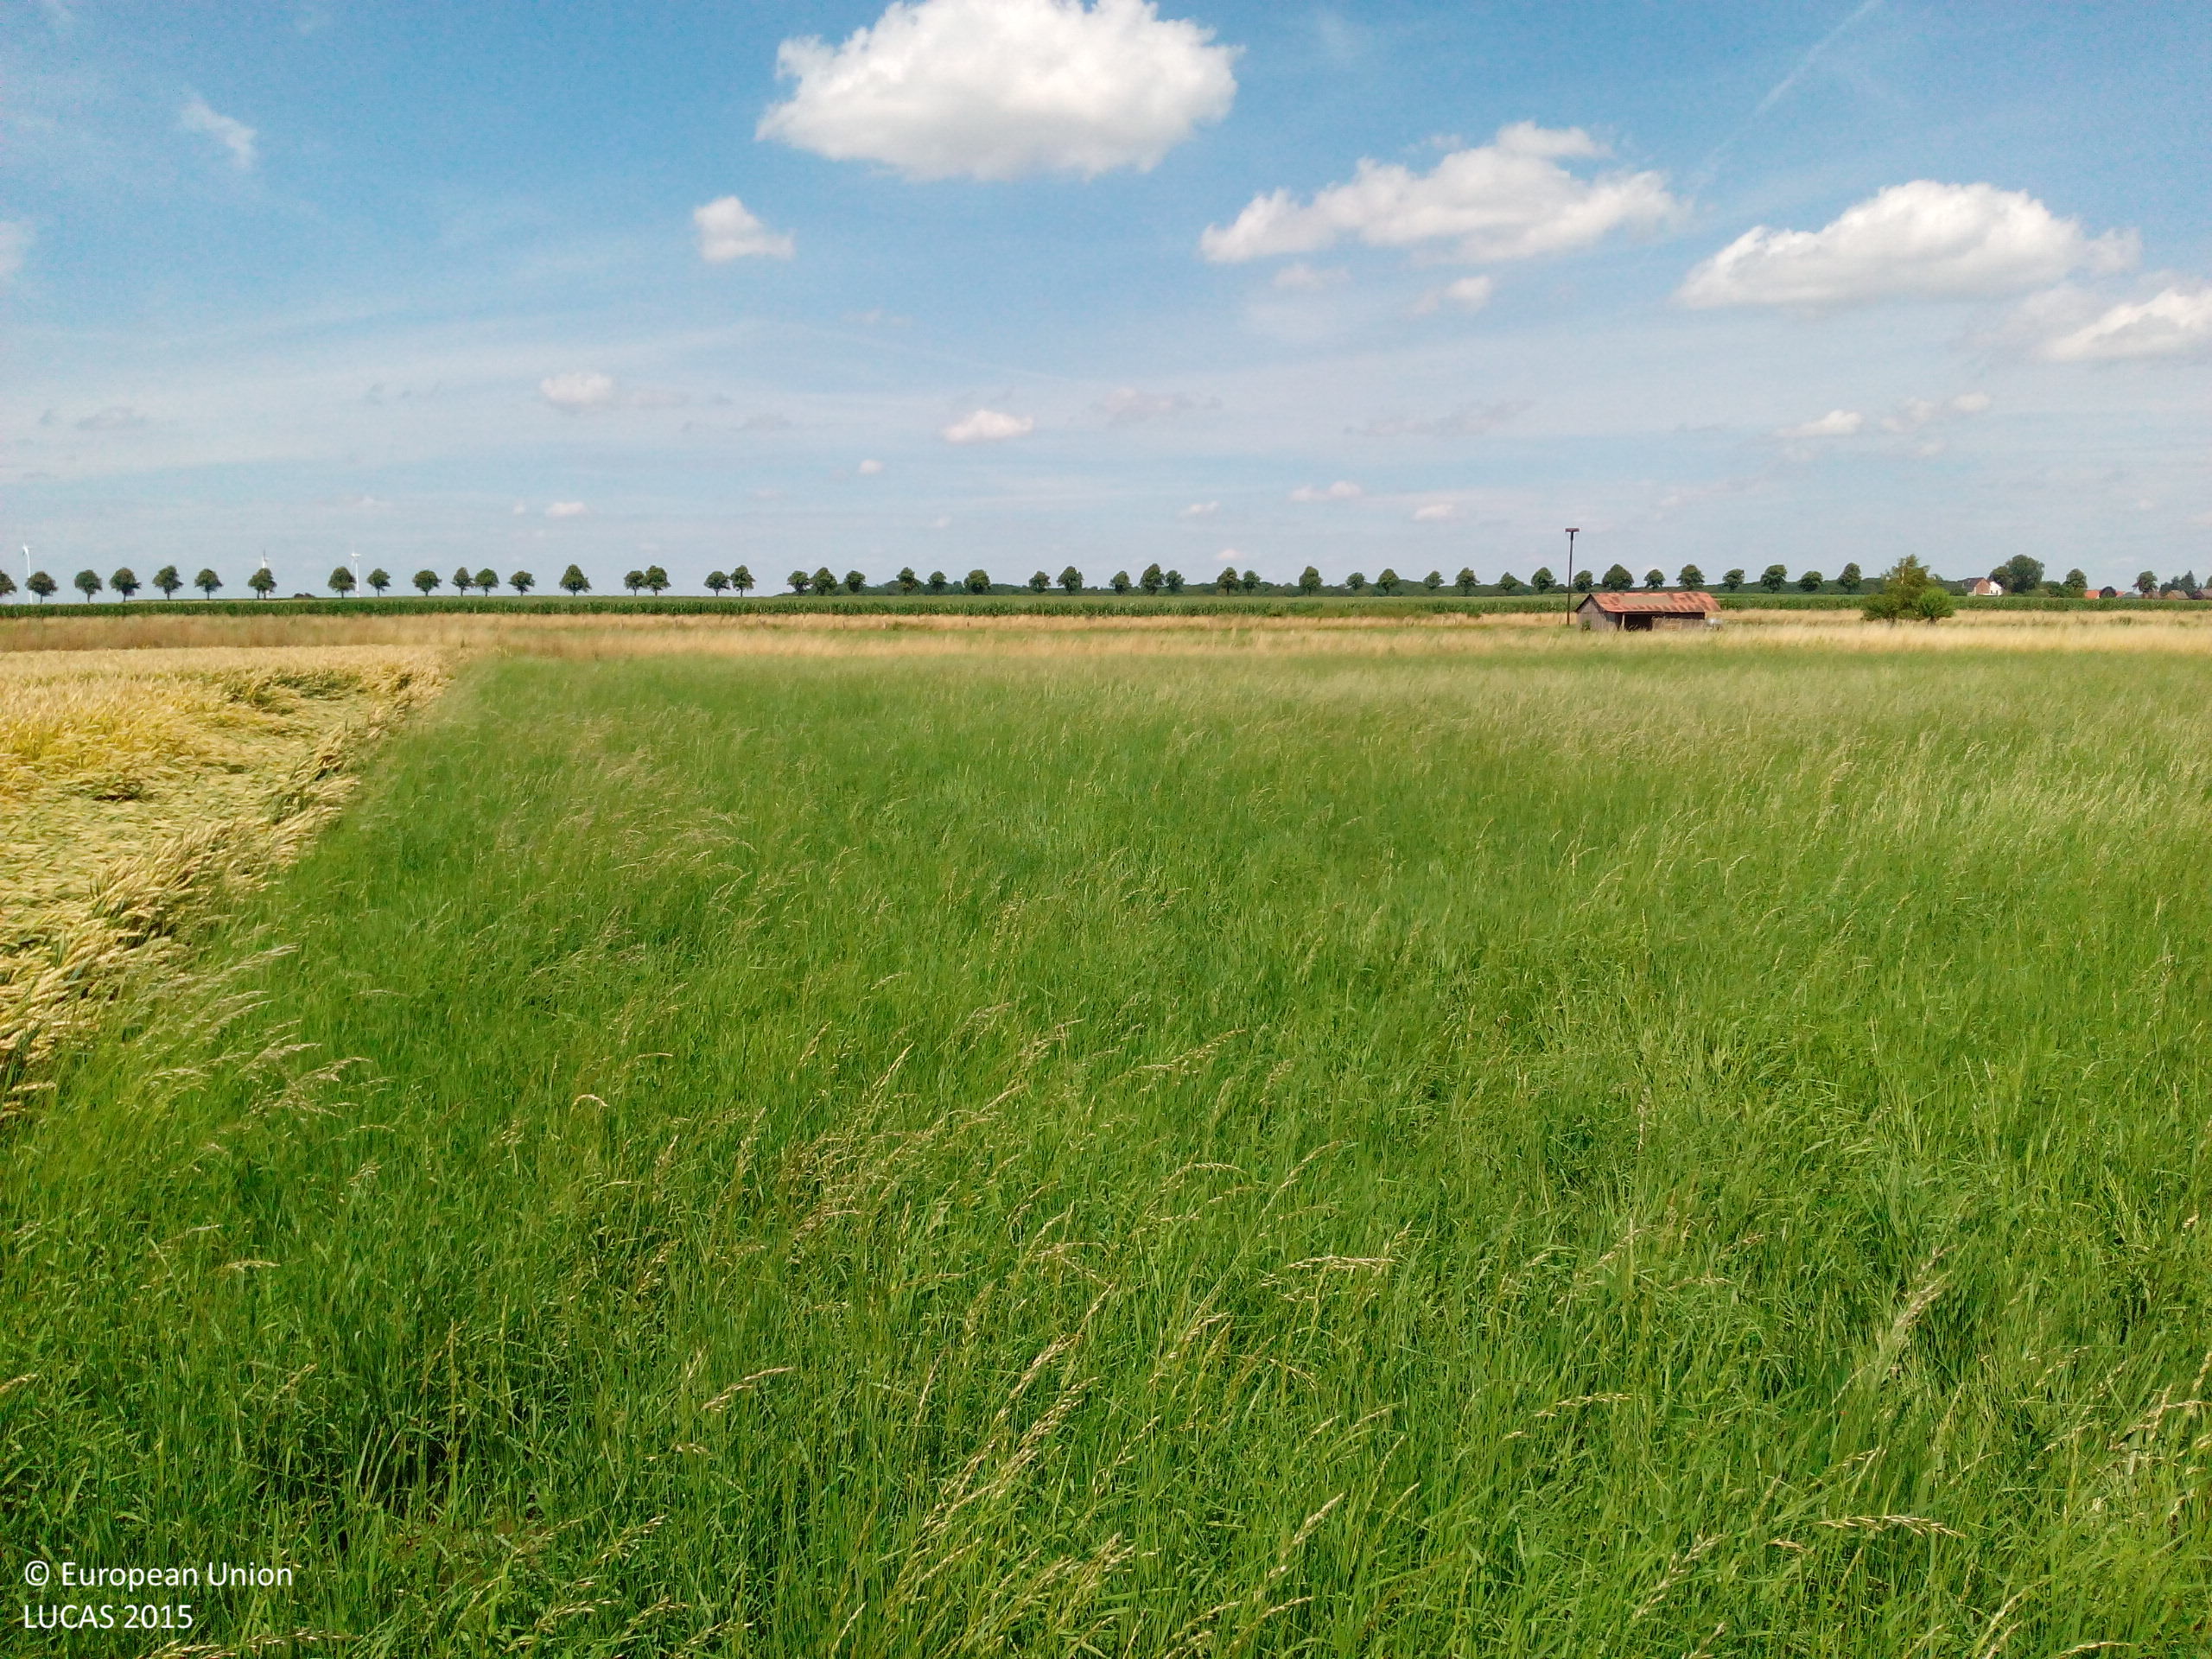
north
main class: Grassland
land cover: Grassland without tree/shrub cover
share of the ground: > 75 %
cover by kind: herbaceous plants 100 %
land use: Agriculture (excluding fallow land and kitchen gardens)
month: July
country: DE
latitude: 52.2154
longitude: 10.2780
